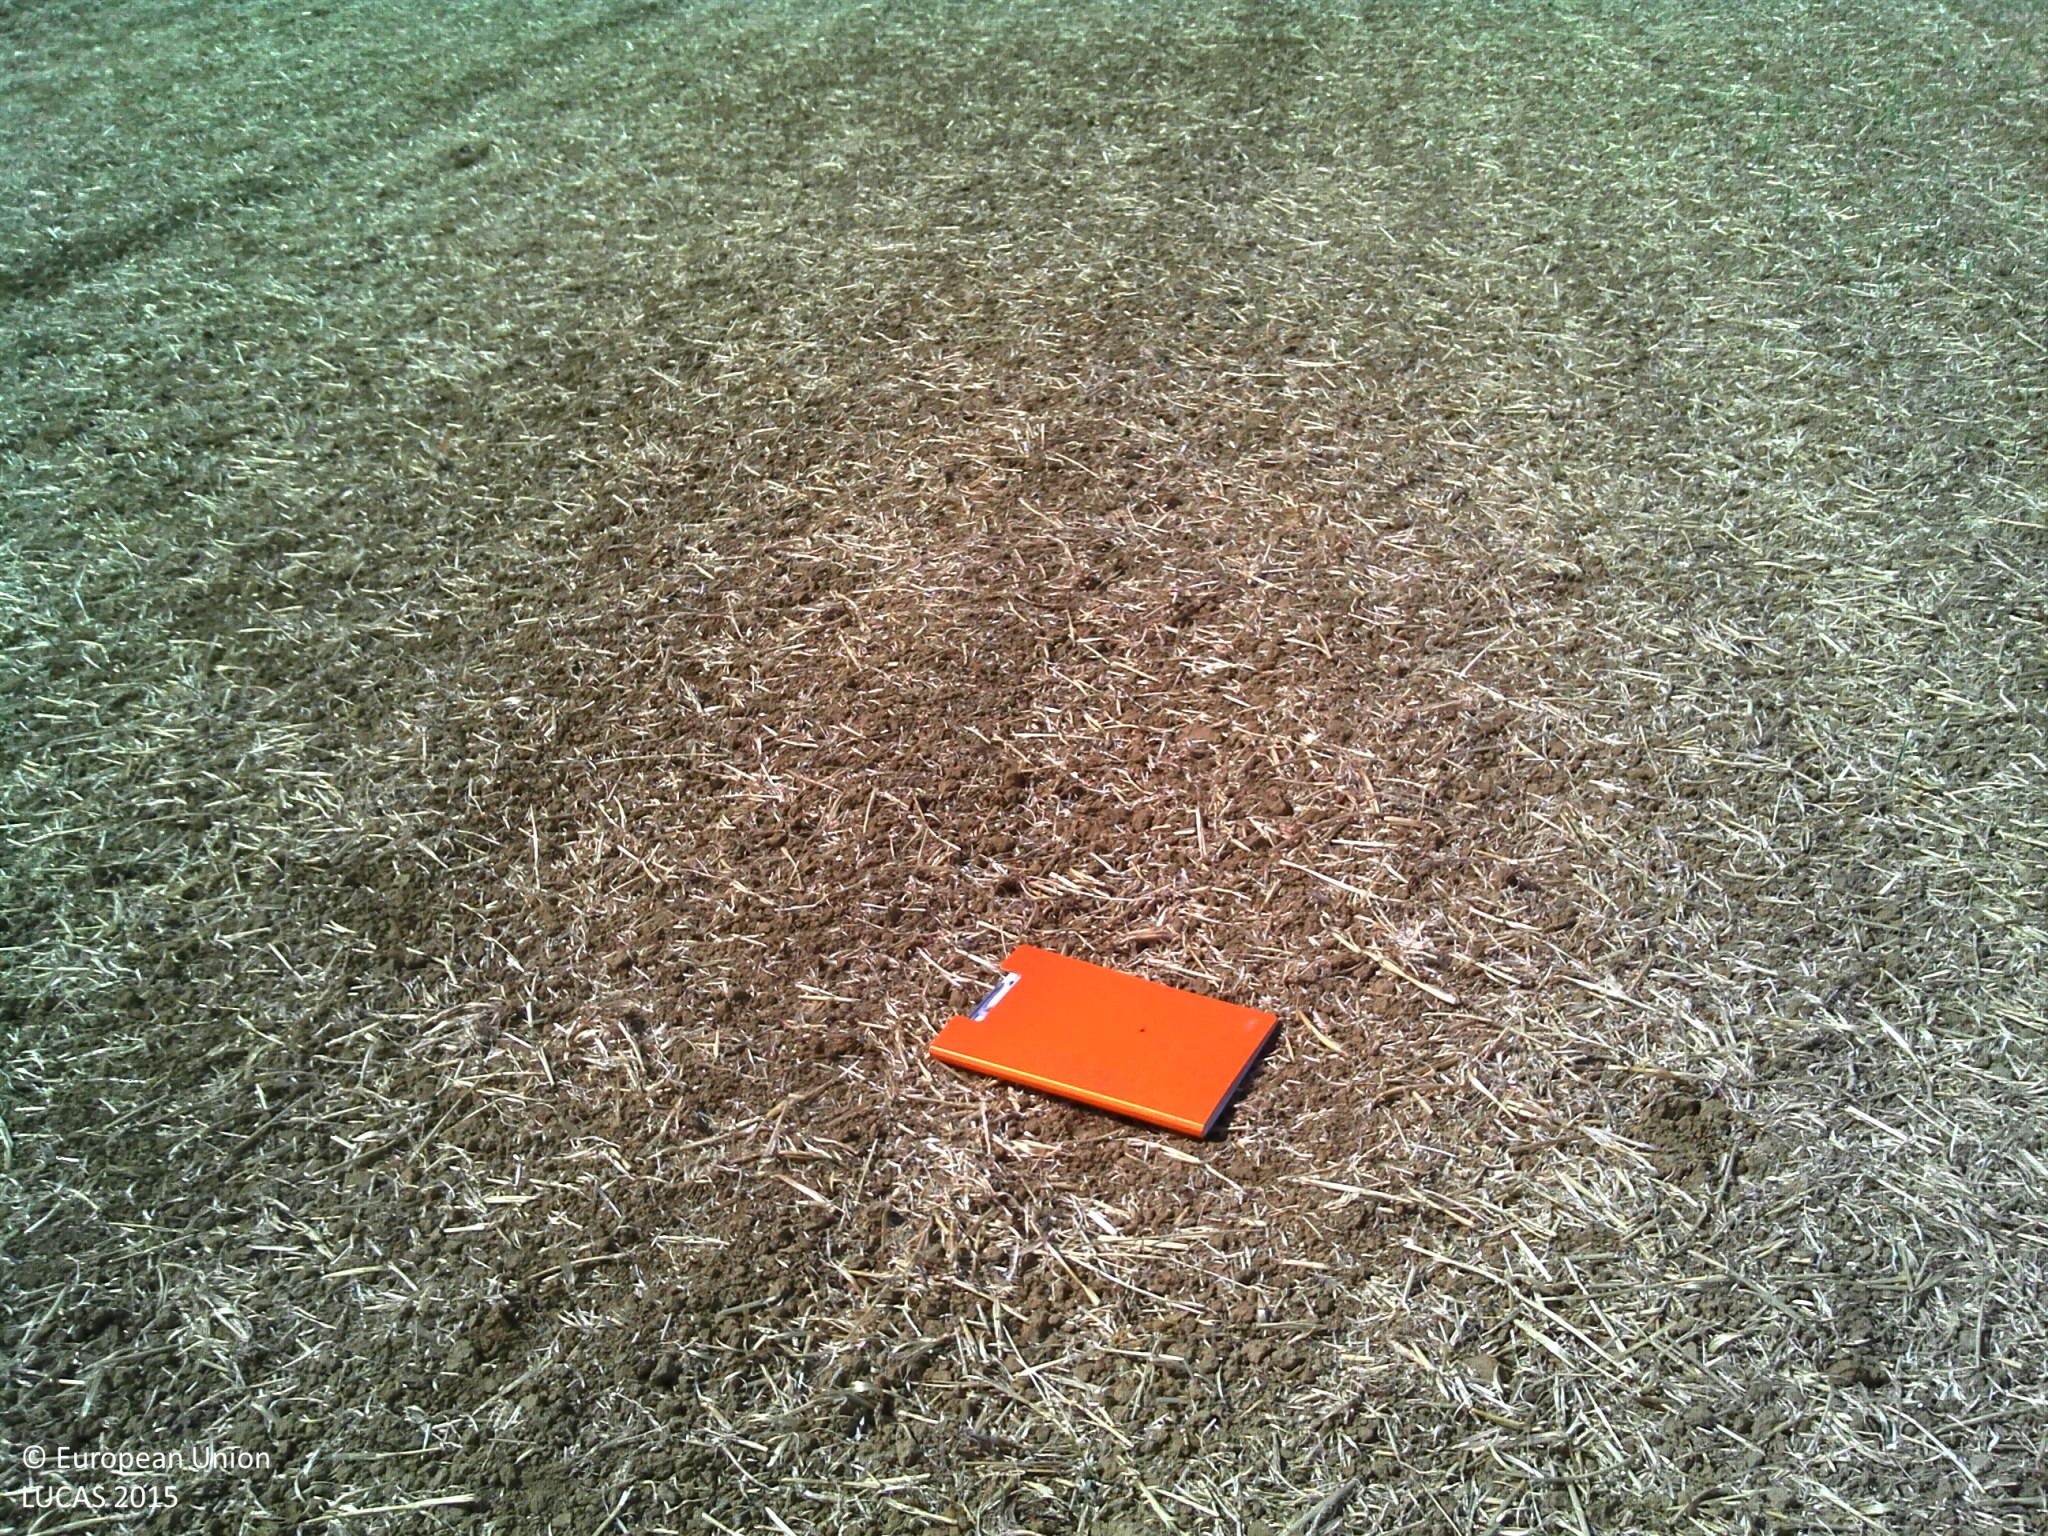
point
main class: Cropland
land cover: Rye
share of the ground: 10 - 25 %
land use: Agriculture (excluding fallow land and kitchen gardens)
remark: Harvested field
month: August
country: FR
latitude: 48.5979
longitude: 5.0219
